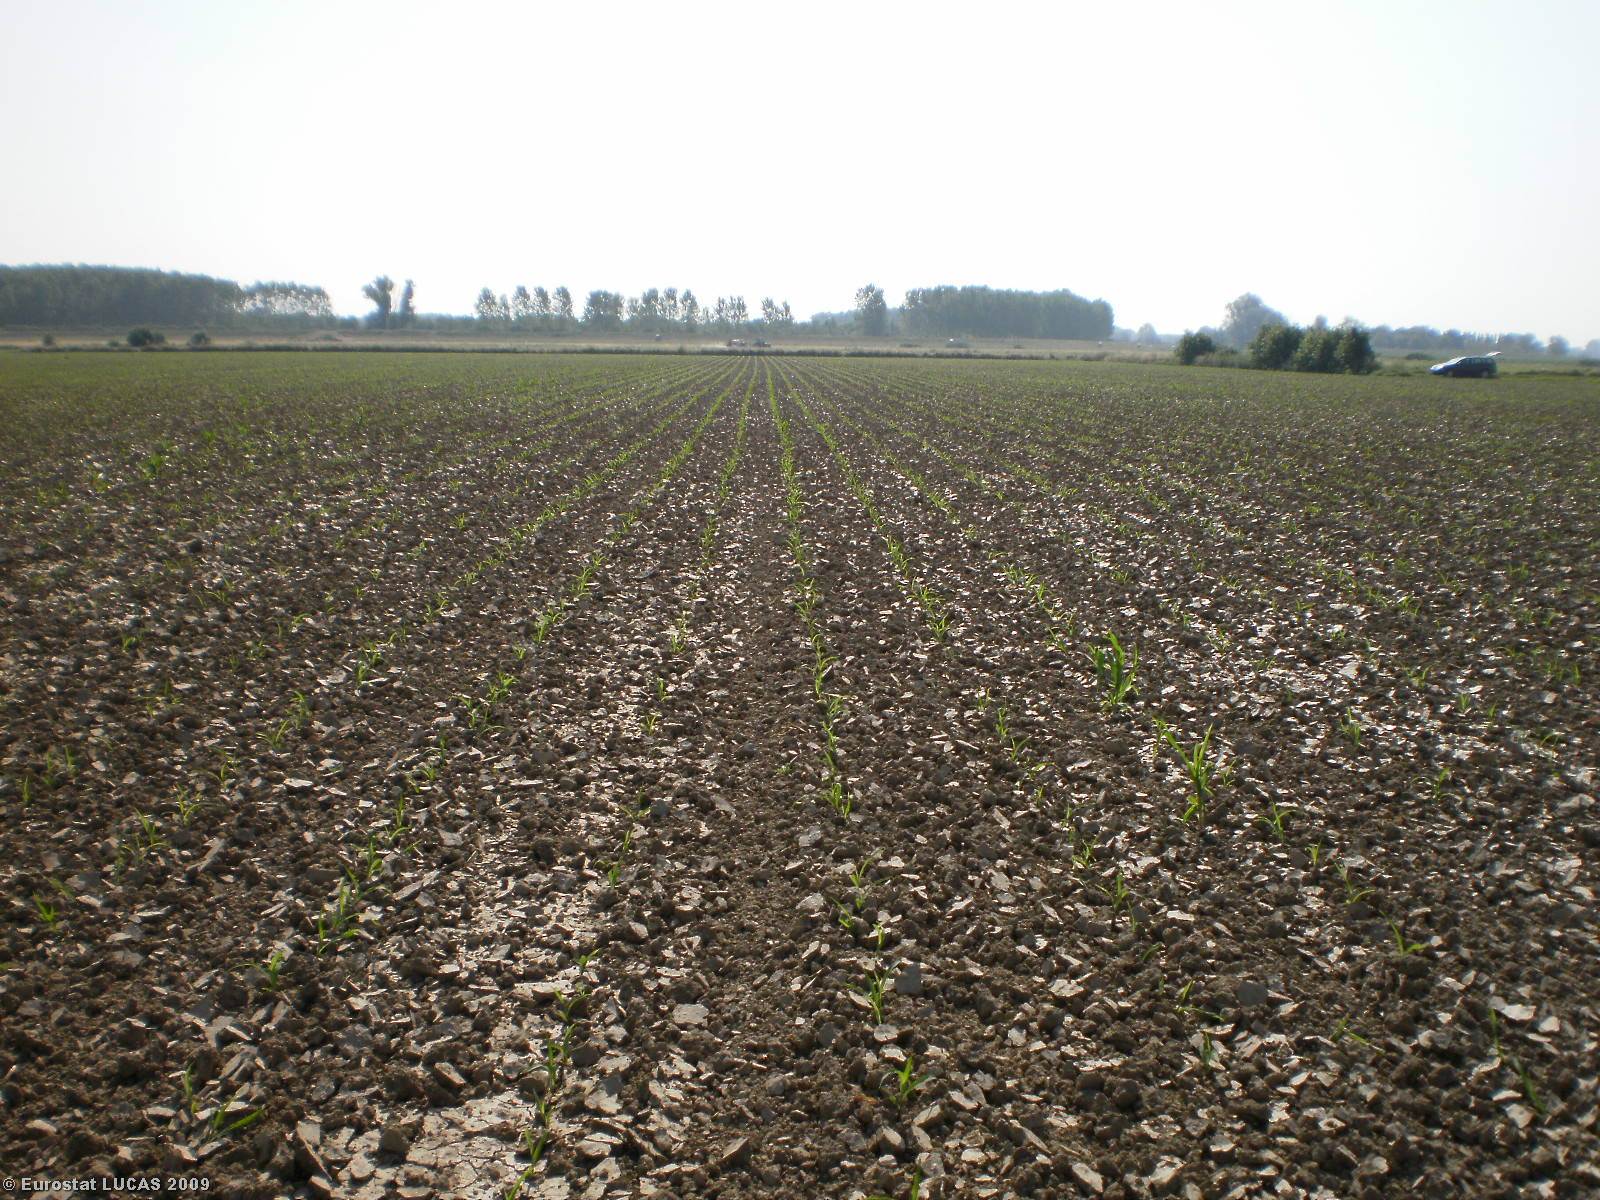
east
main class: Cropland
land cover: Maize
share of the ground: 10 - 25 %
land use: Agriculture (excluding fallow land and kitchen gardens)
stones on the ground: < 10 %
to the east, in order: Maize; Grass margins; Ditches and canals; Grass margins; Common wheat
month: June
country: IT
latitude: 45.1614
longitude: 10.3428
